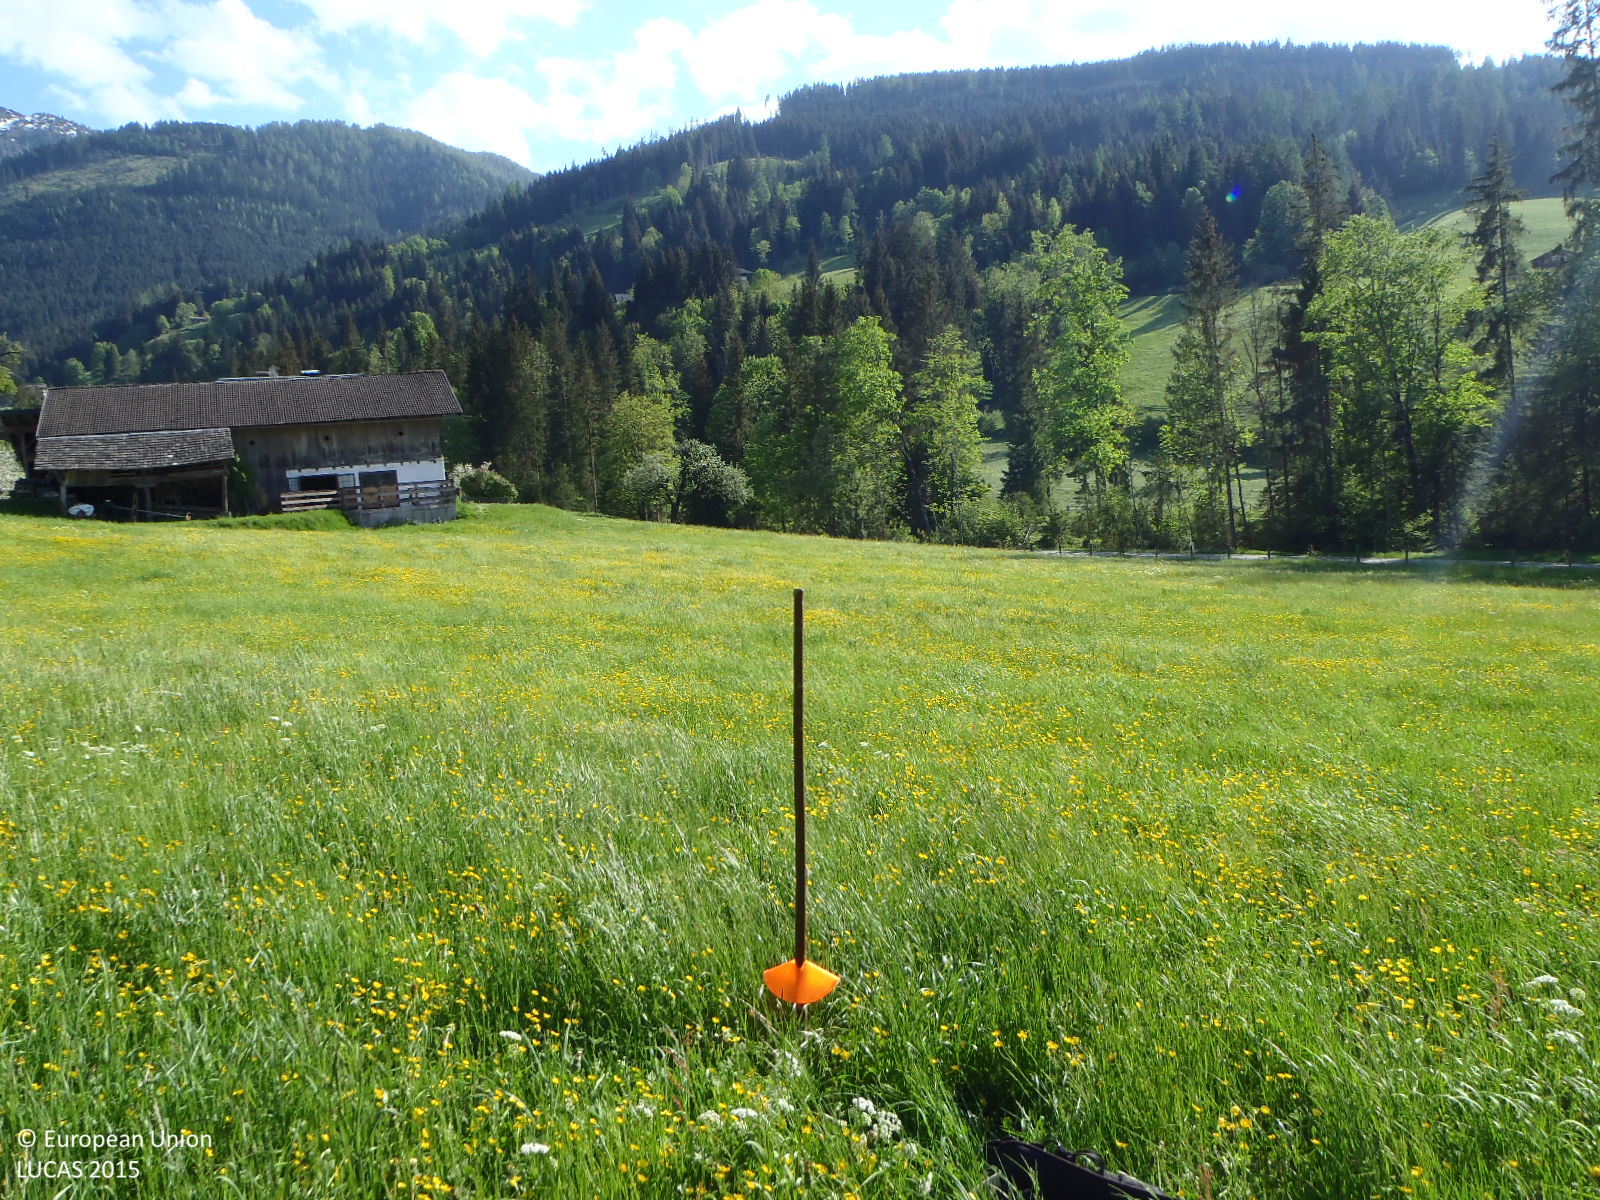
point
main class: Grassland
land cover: Grassland without tree/shrub cover
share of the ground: > 75 %
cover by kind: herbaceous plants 100 %
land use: Agriculture (excluding fallow land and kitchen gardens)
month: May
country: AT
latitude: 47.3597
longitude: 13.4274
